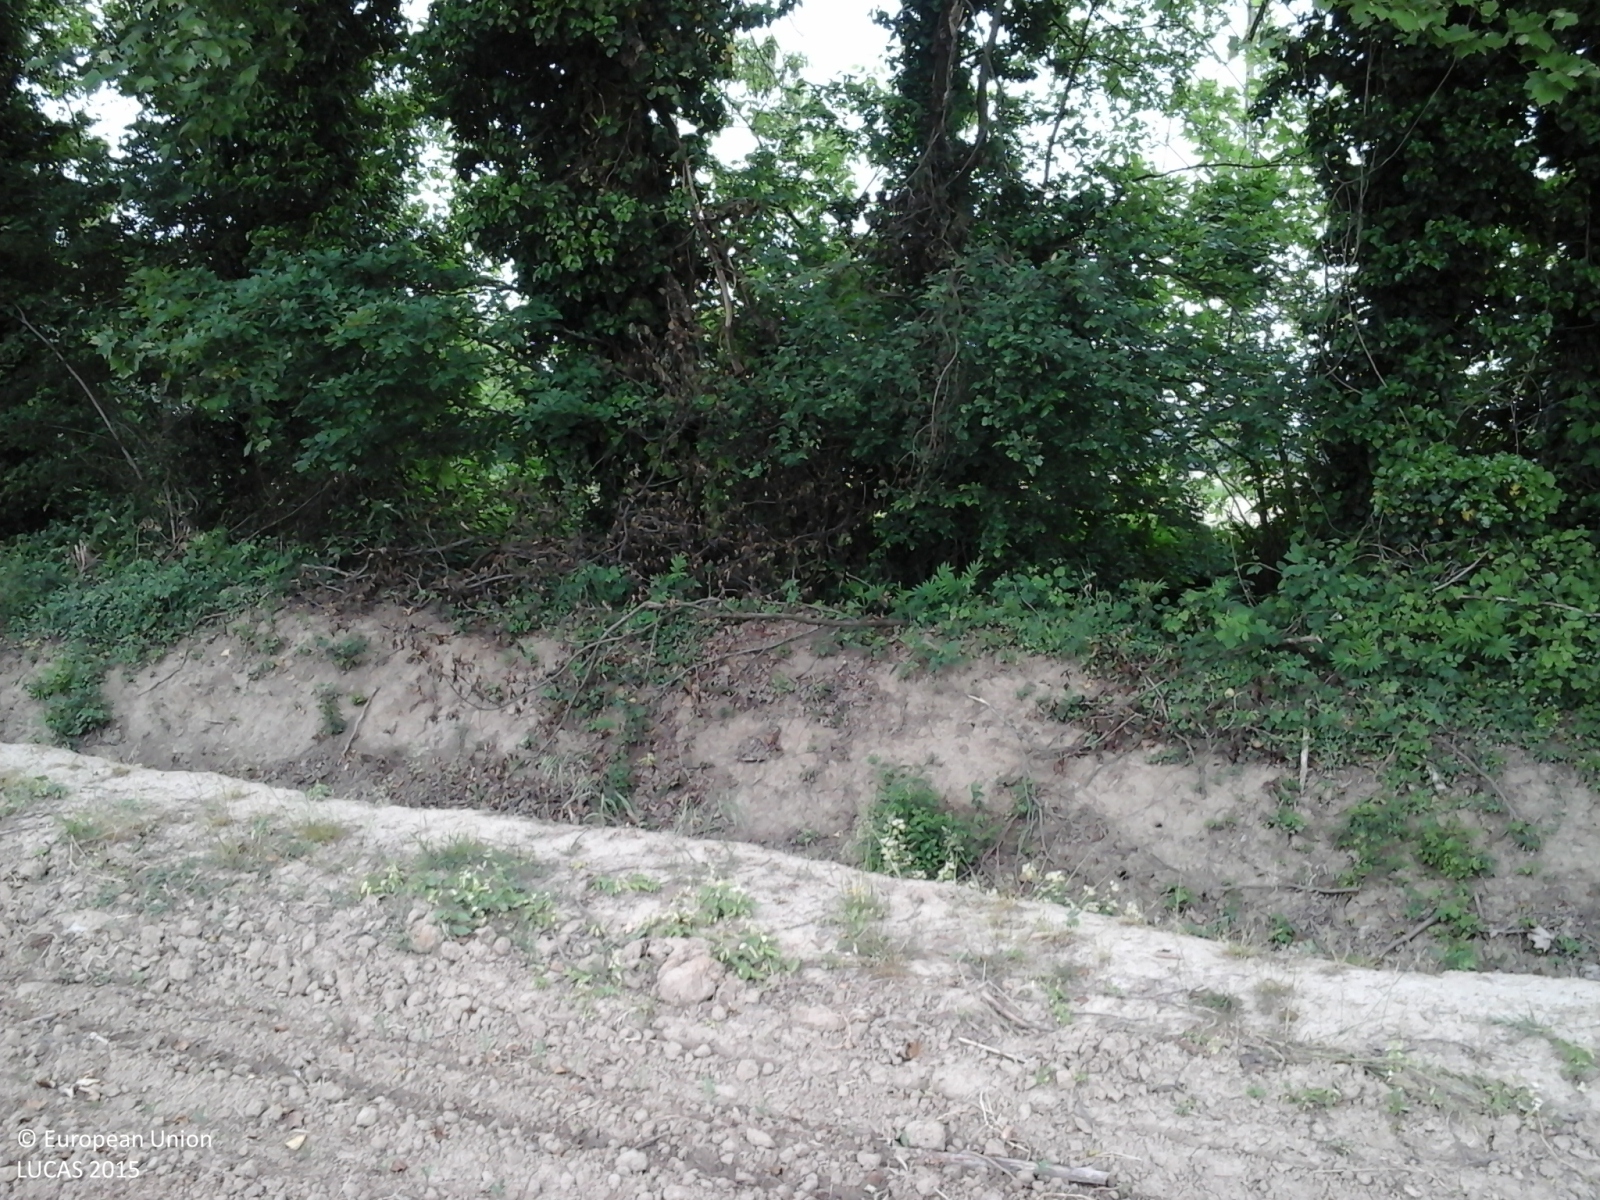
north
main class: Cropland
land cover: Maize
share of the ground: < 10 %
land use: Agriculture (excluding fallow land and kitchen gardens)
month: May
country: IT
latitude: 45.2340
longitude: 9.9110
